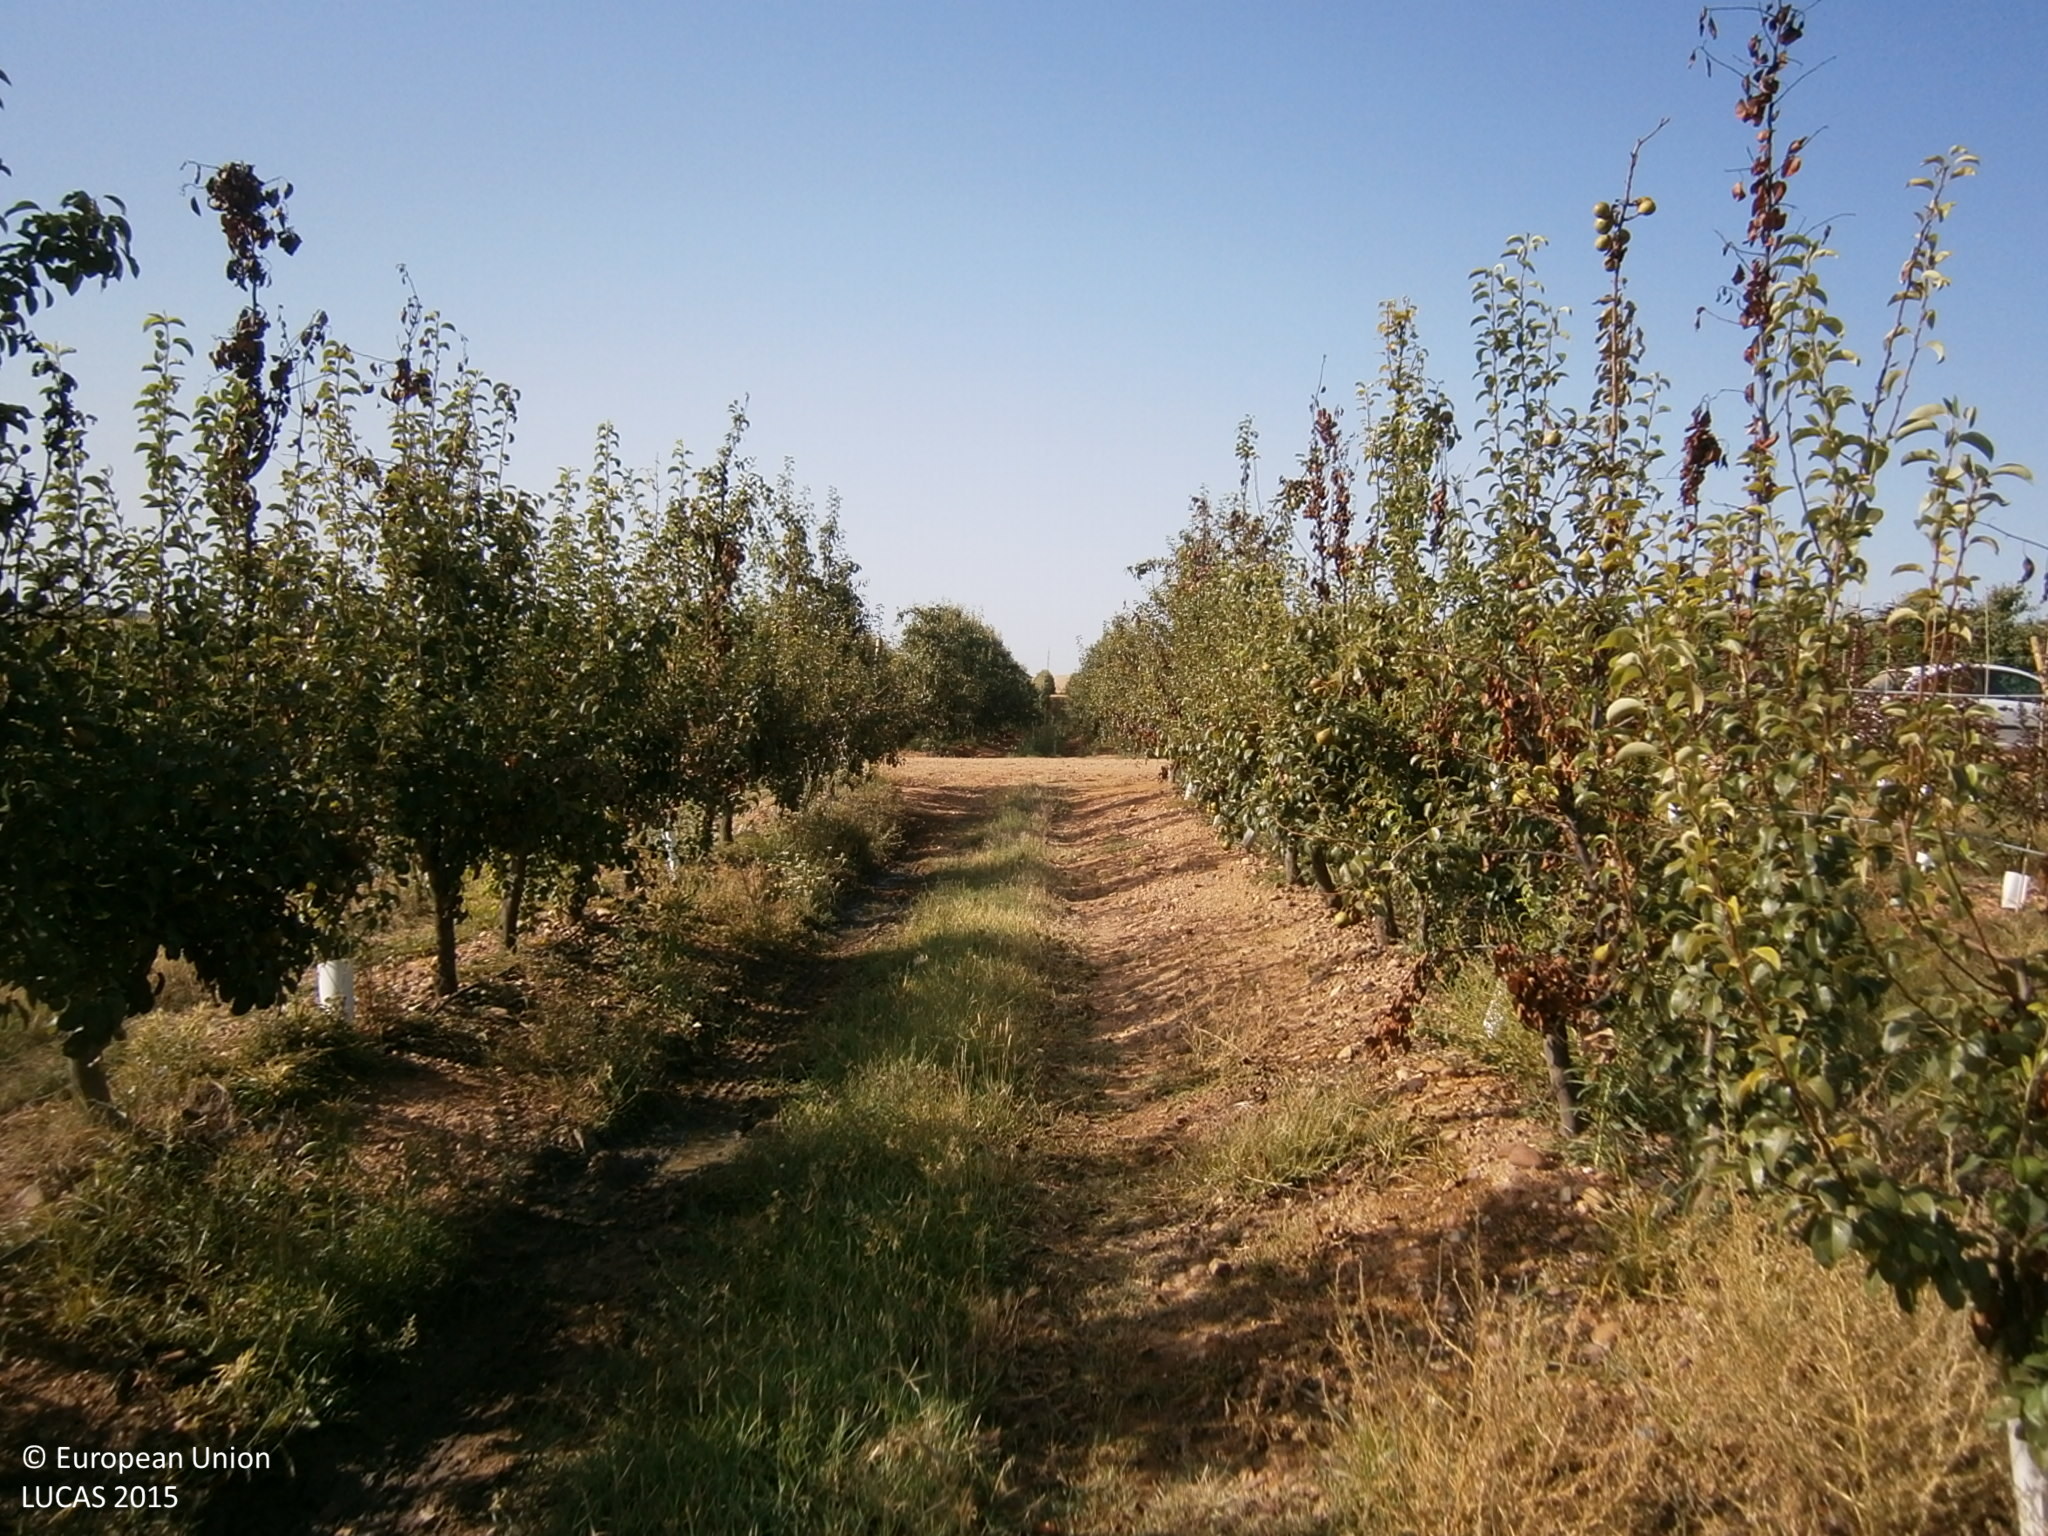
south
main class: Cropland
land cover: Pear fruit
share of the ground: 25 - 50 %
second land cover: Spontaneously vegetated surfaces
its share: 25 - 50 %
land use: Agriculture (excluding fallow land and kitchen gardens)
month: July
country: ES
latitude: 38.8740
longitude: -6.8377
